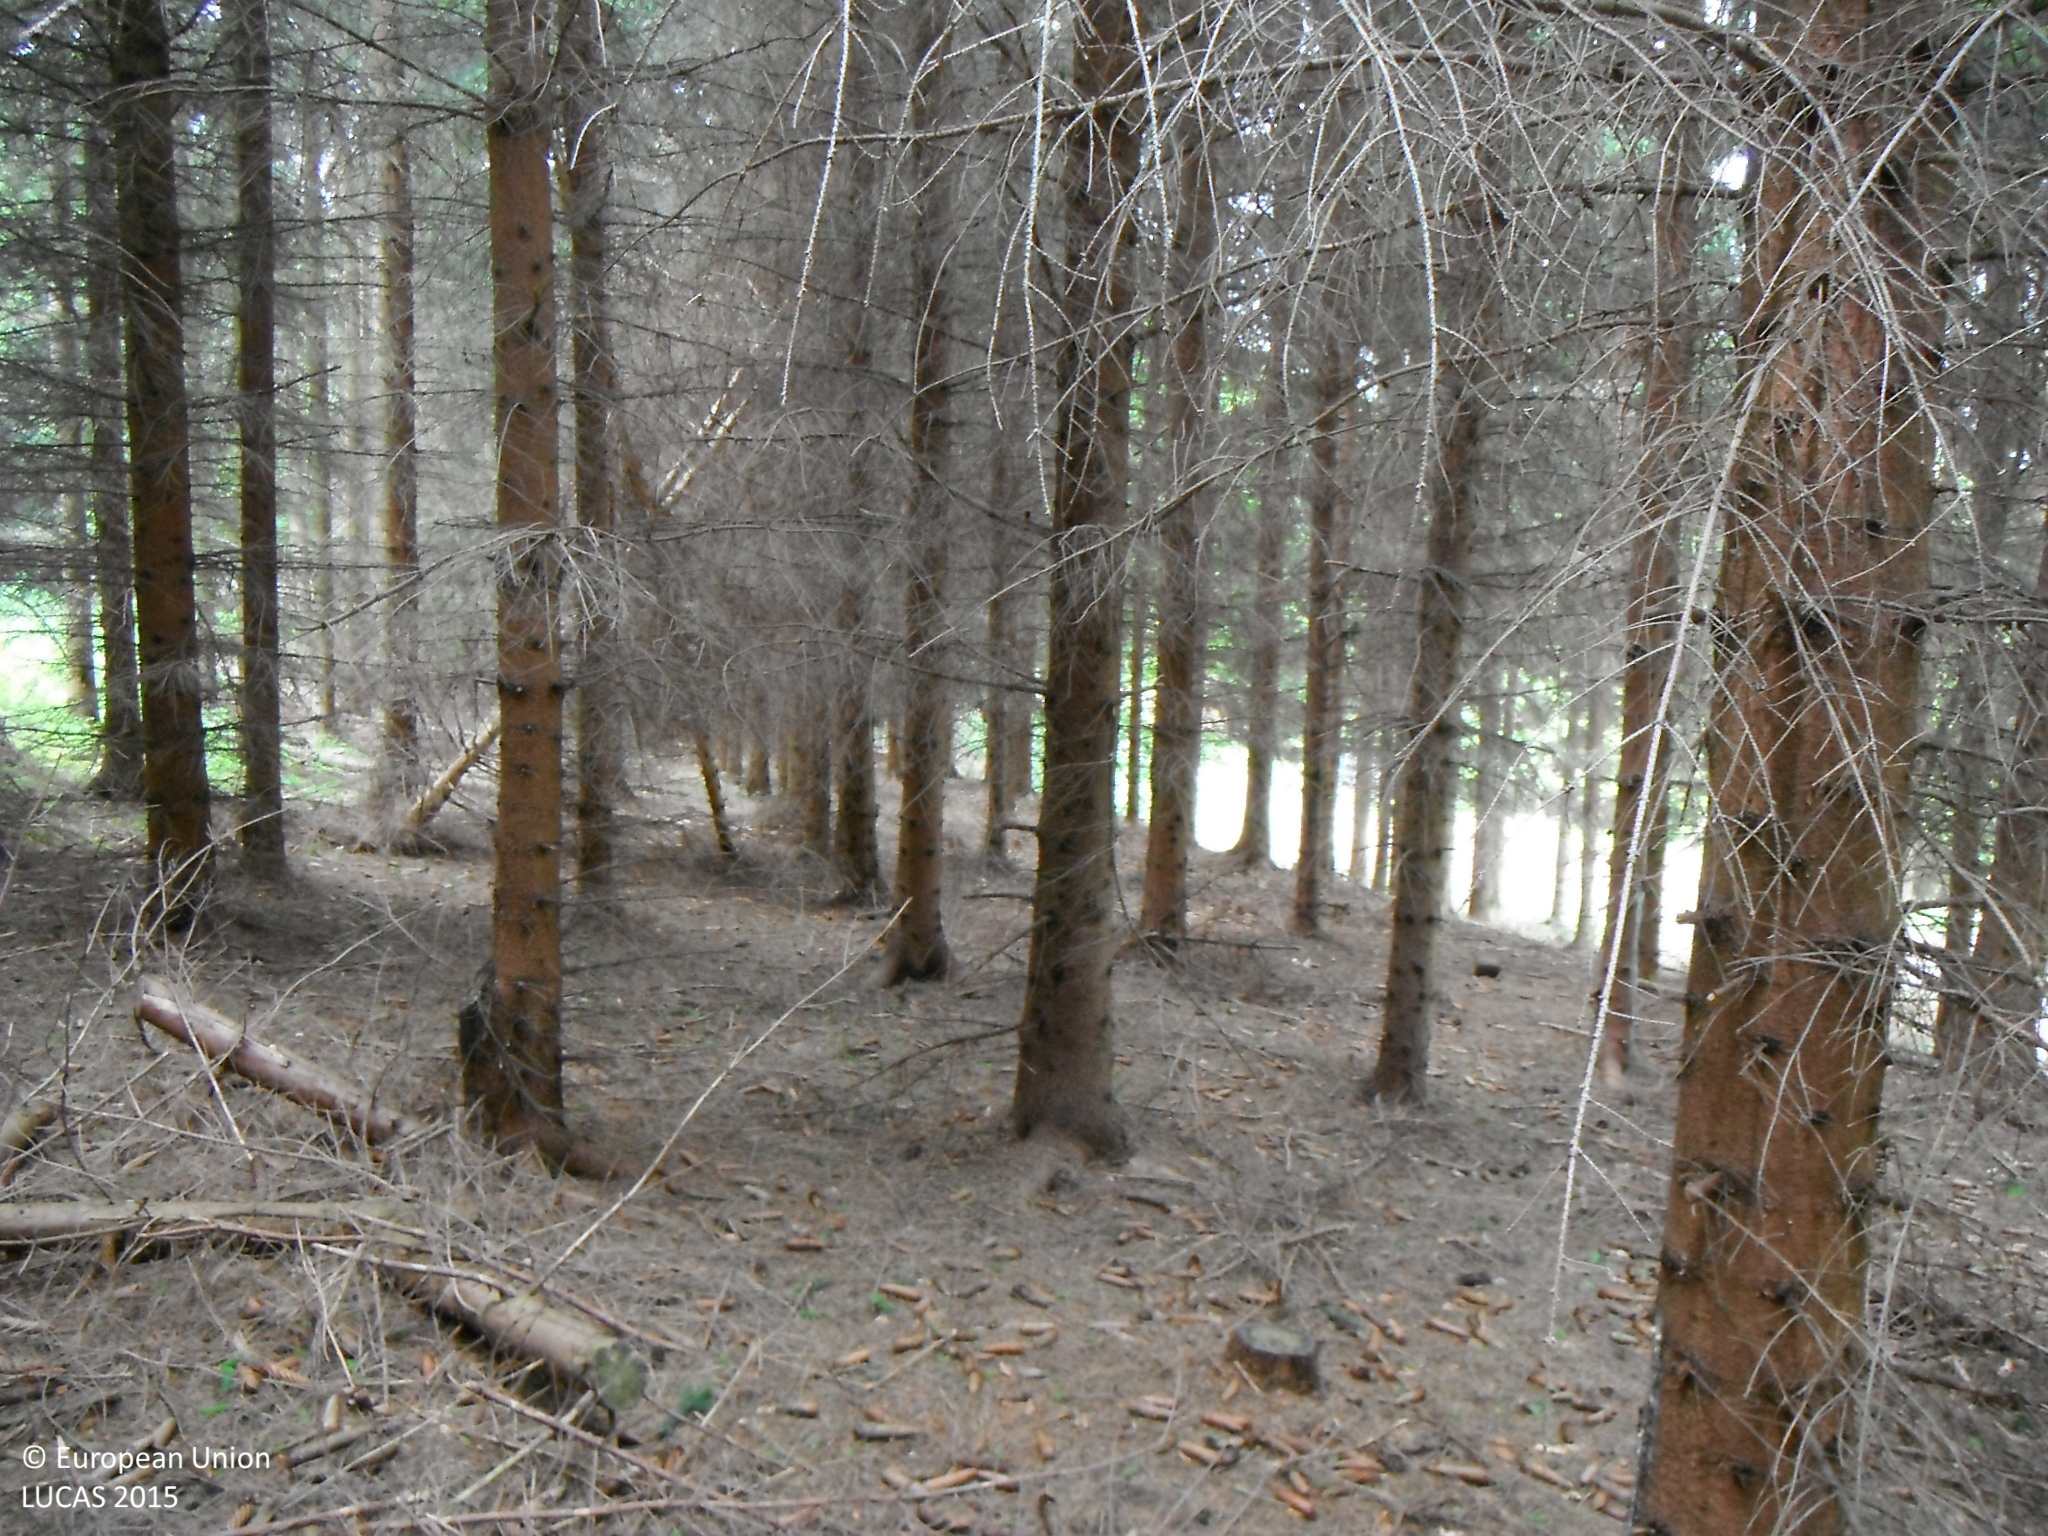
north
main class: Woodland
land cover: Spruce dominated coniferous woodland
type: alpine coniferous forest
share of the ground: > 75 %
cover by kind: coniferous forest trees 100 %
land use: Forestry
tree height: > 5 m
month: June
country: SK
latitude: 48.4377
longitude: 19.3911
